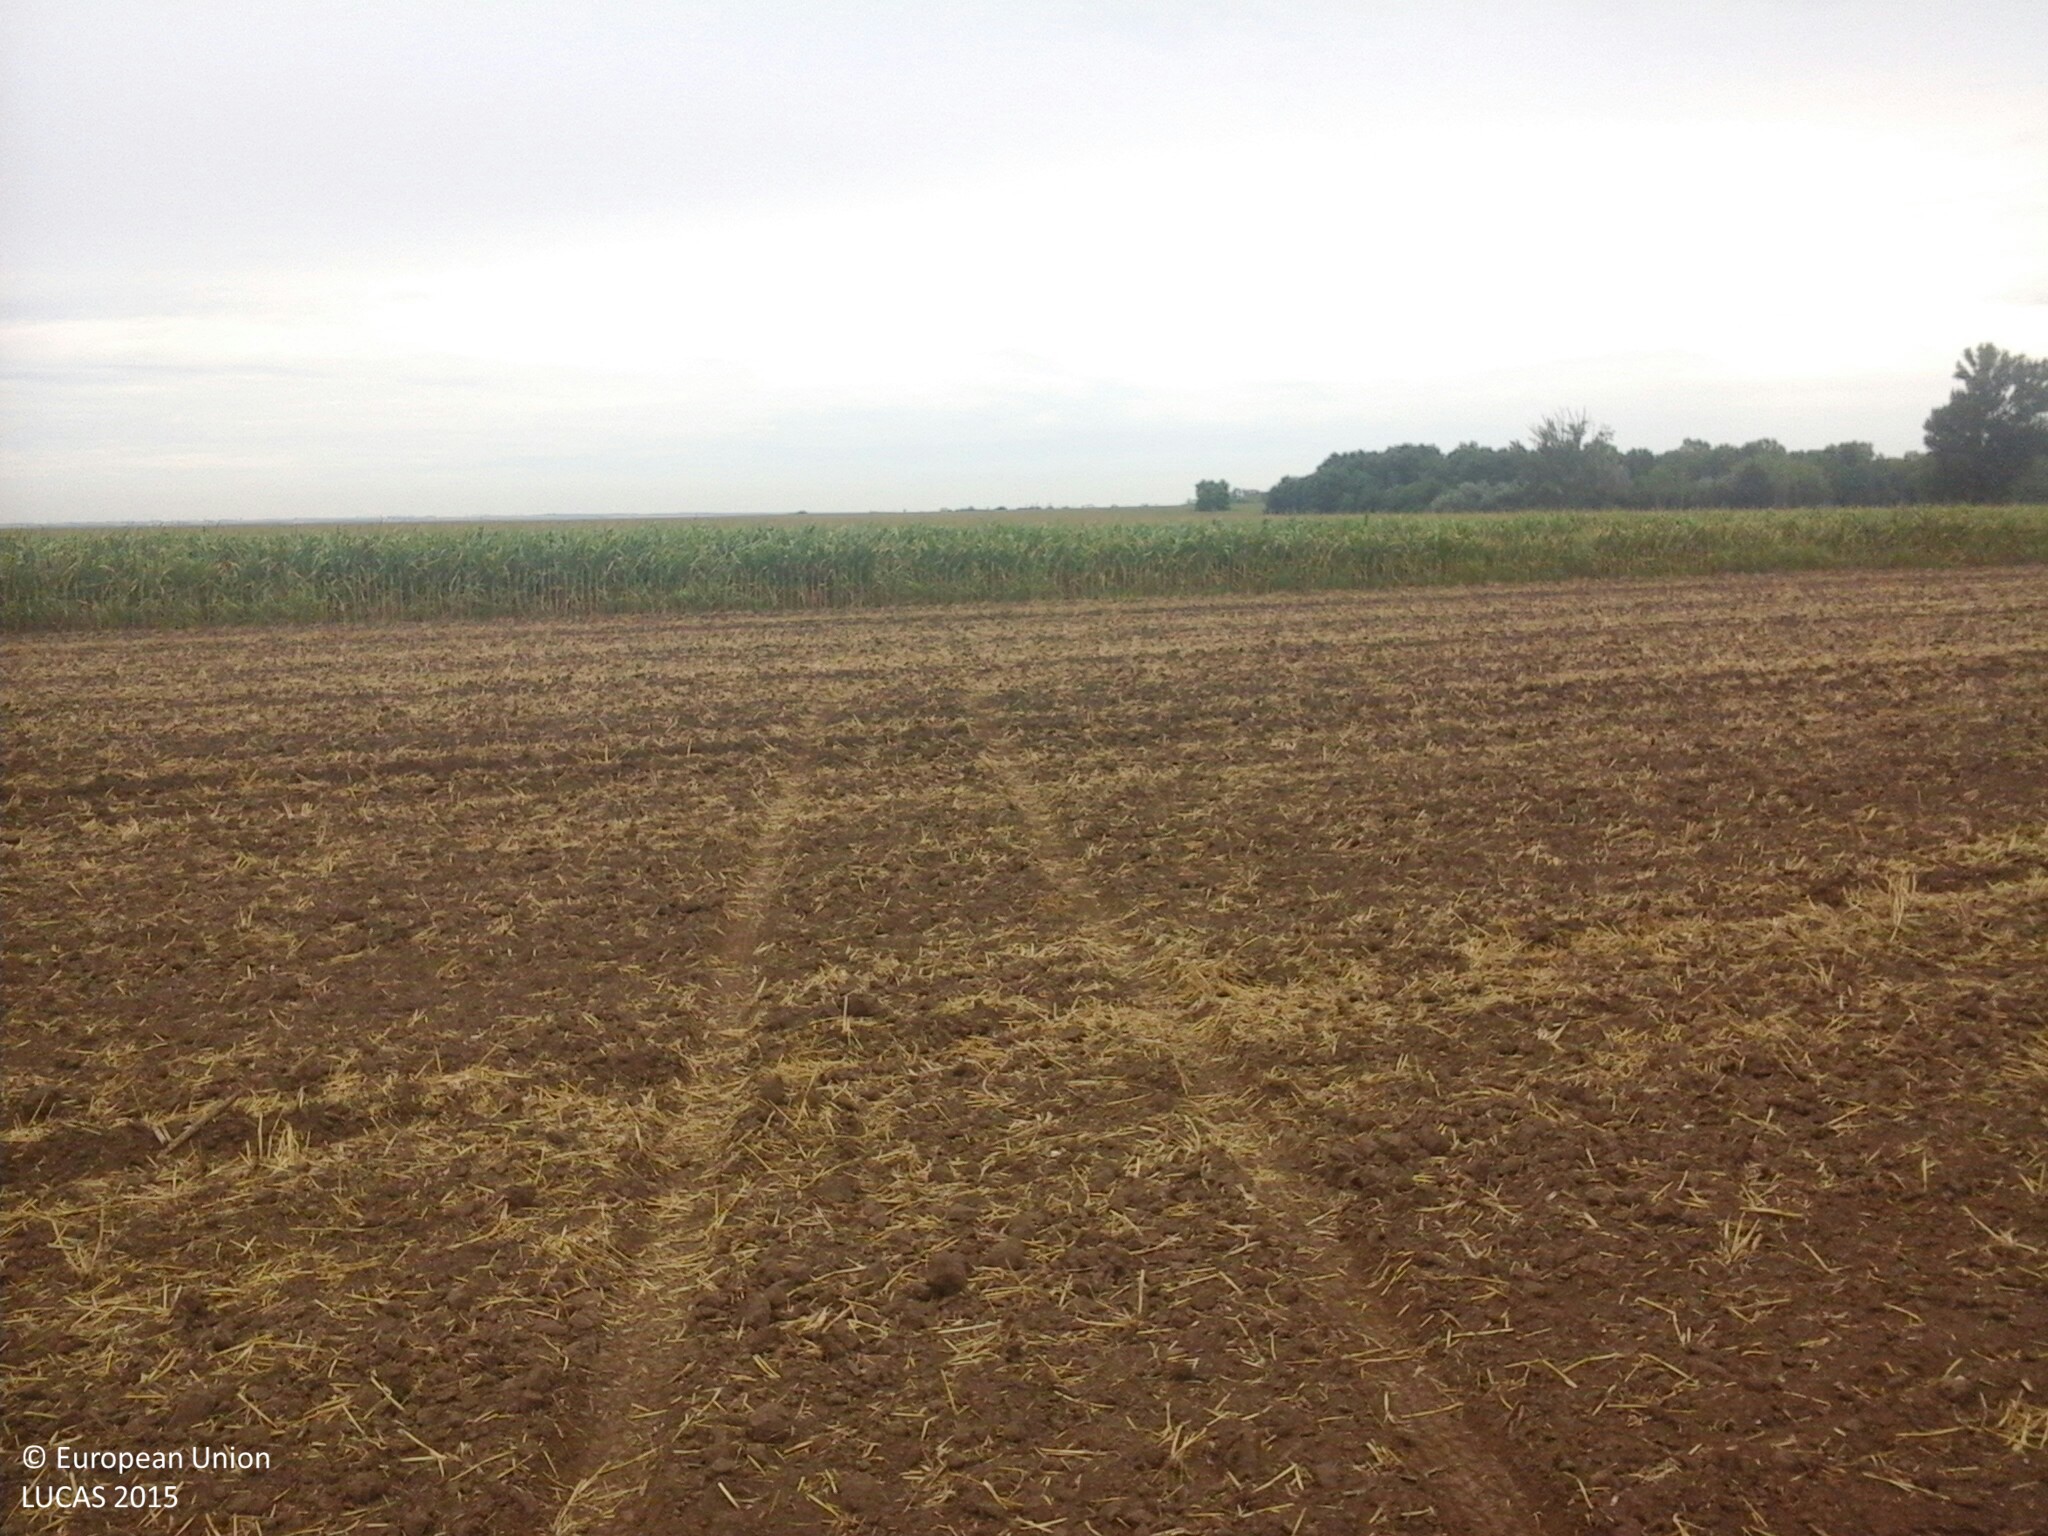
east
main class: Cropland
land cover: Common wheat
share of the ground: < 10 %
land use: Agriculture (excluding fallow land and kitchen gardens)
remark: Harvested field
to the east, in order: Common wheat; Maize
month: July
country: HU
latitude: 47.0166
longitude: 18.3914
